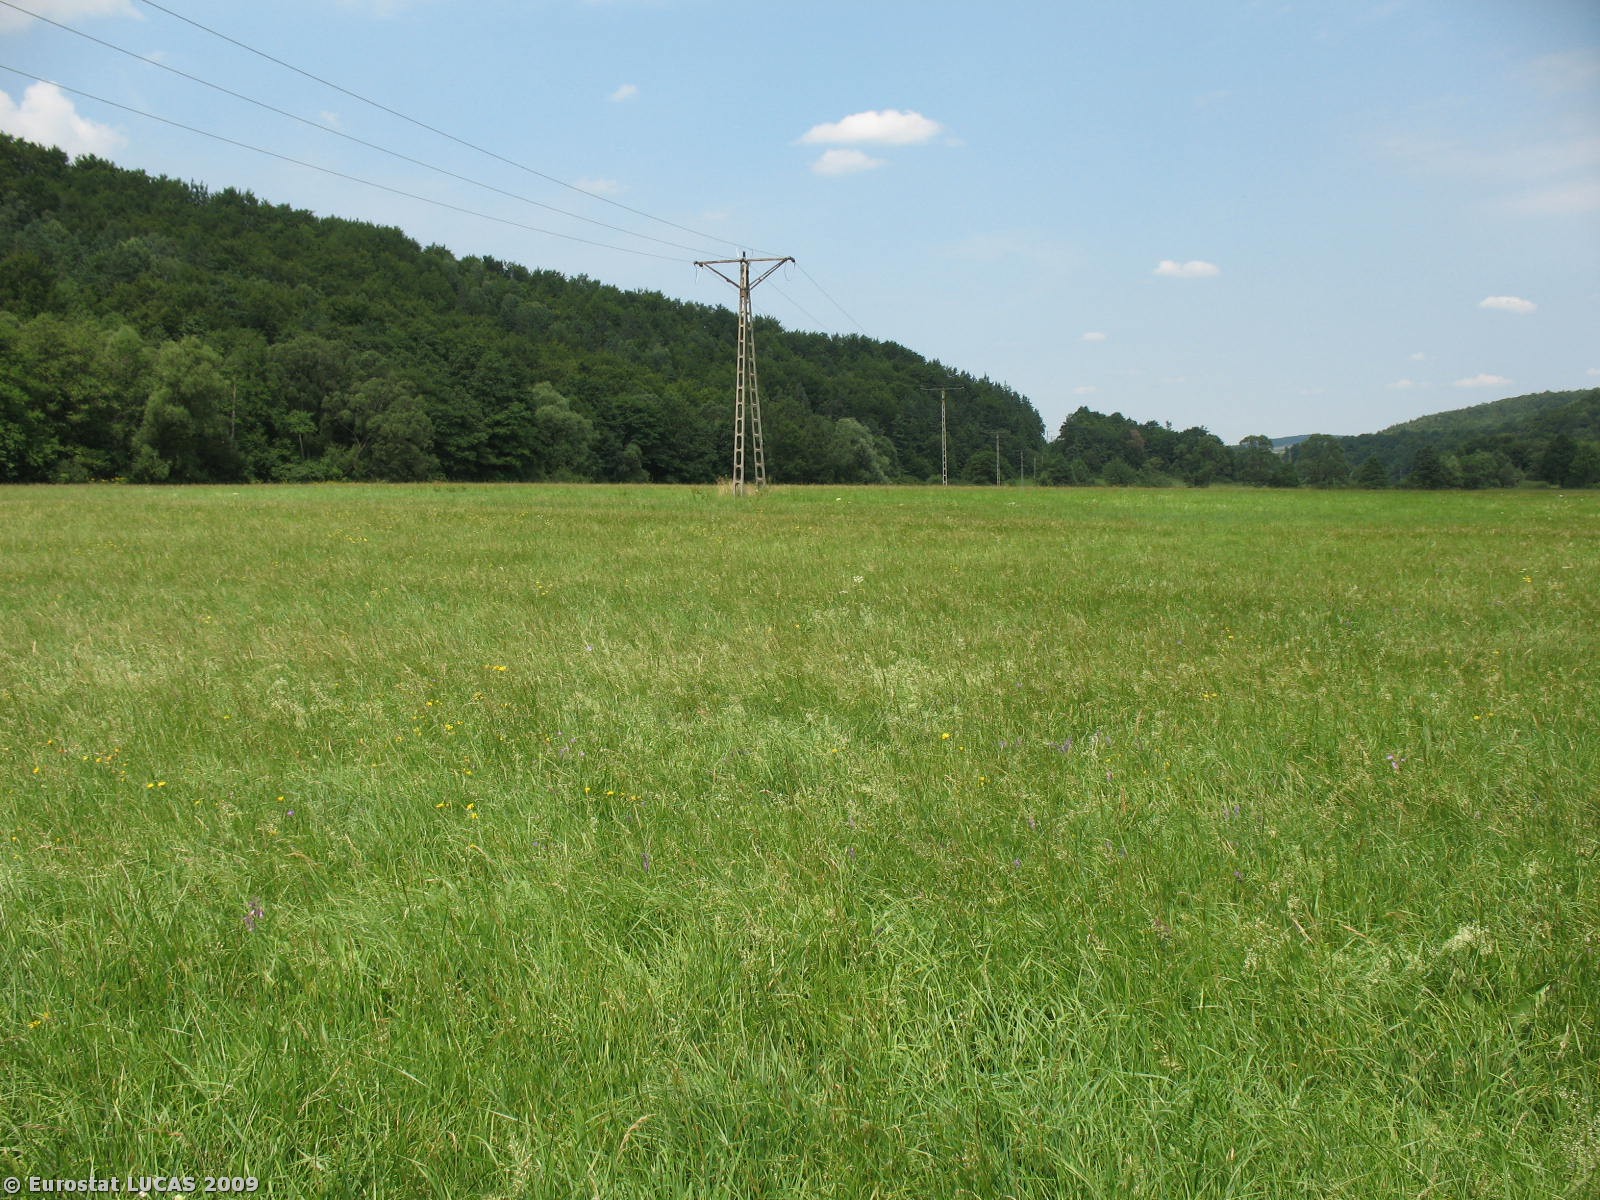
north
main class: Grassland
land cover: Grassland without tree/shrub cover
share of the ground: > 75 %
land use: Agriculture (excluding fallow land and kitchen gardens)
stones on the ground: < 10 %
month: July
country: PL
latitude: 49.5198
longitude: 21.9213
